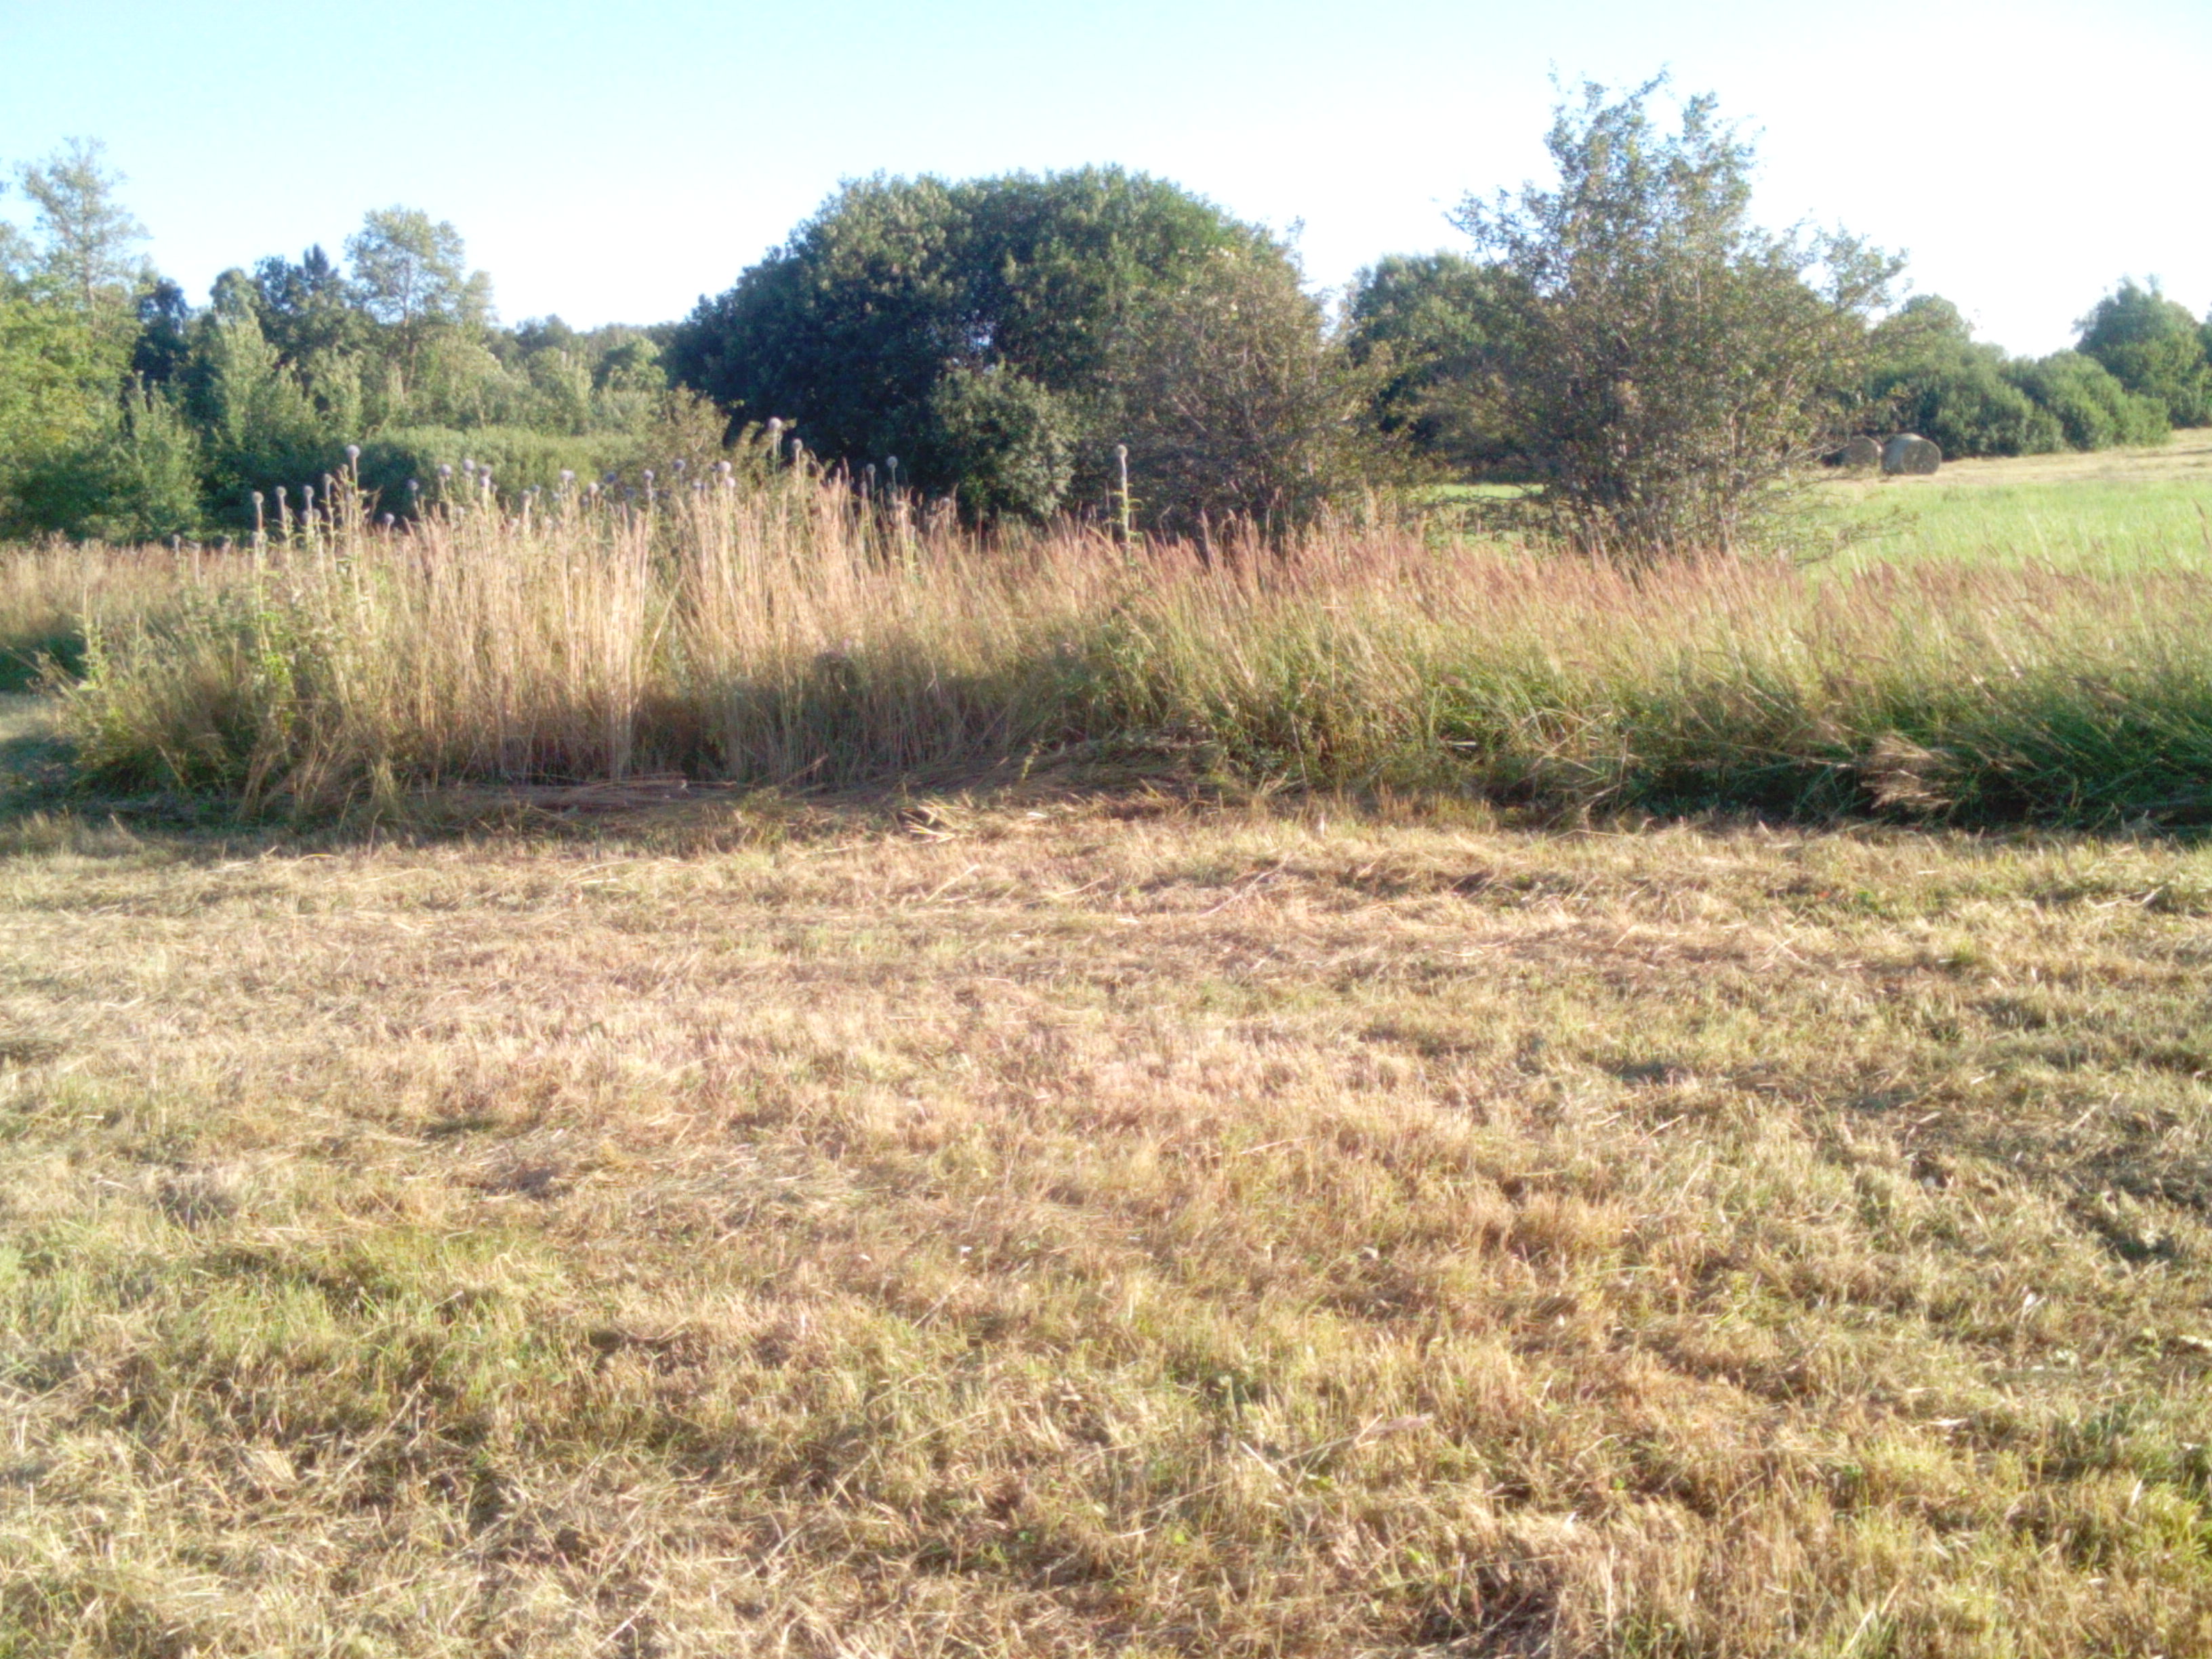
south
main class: Grassland
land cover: Grassland without tree/shrub cover
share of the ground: > 75 %
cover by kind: herbaceous plants 100 %
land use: Agriculture (excluding fallow land and kitchen gardens)
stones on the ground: < 10 %
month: August
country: LV
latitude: 56.5523
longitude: 21.3790
